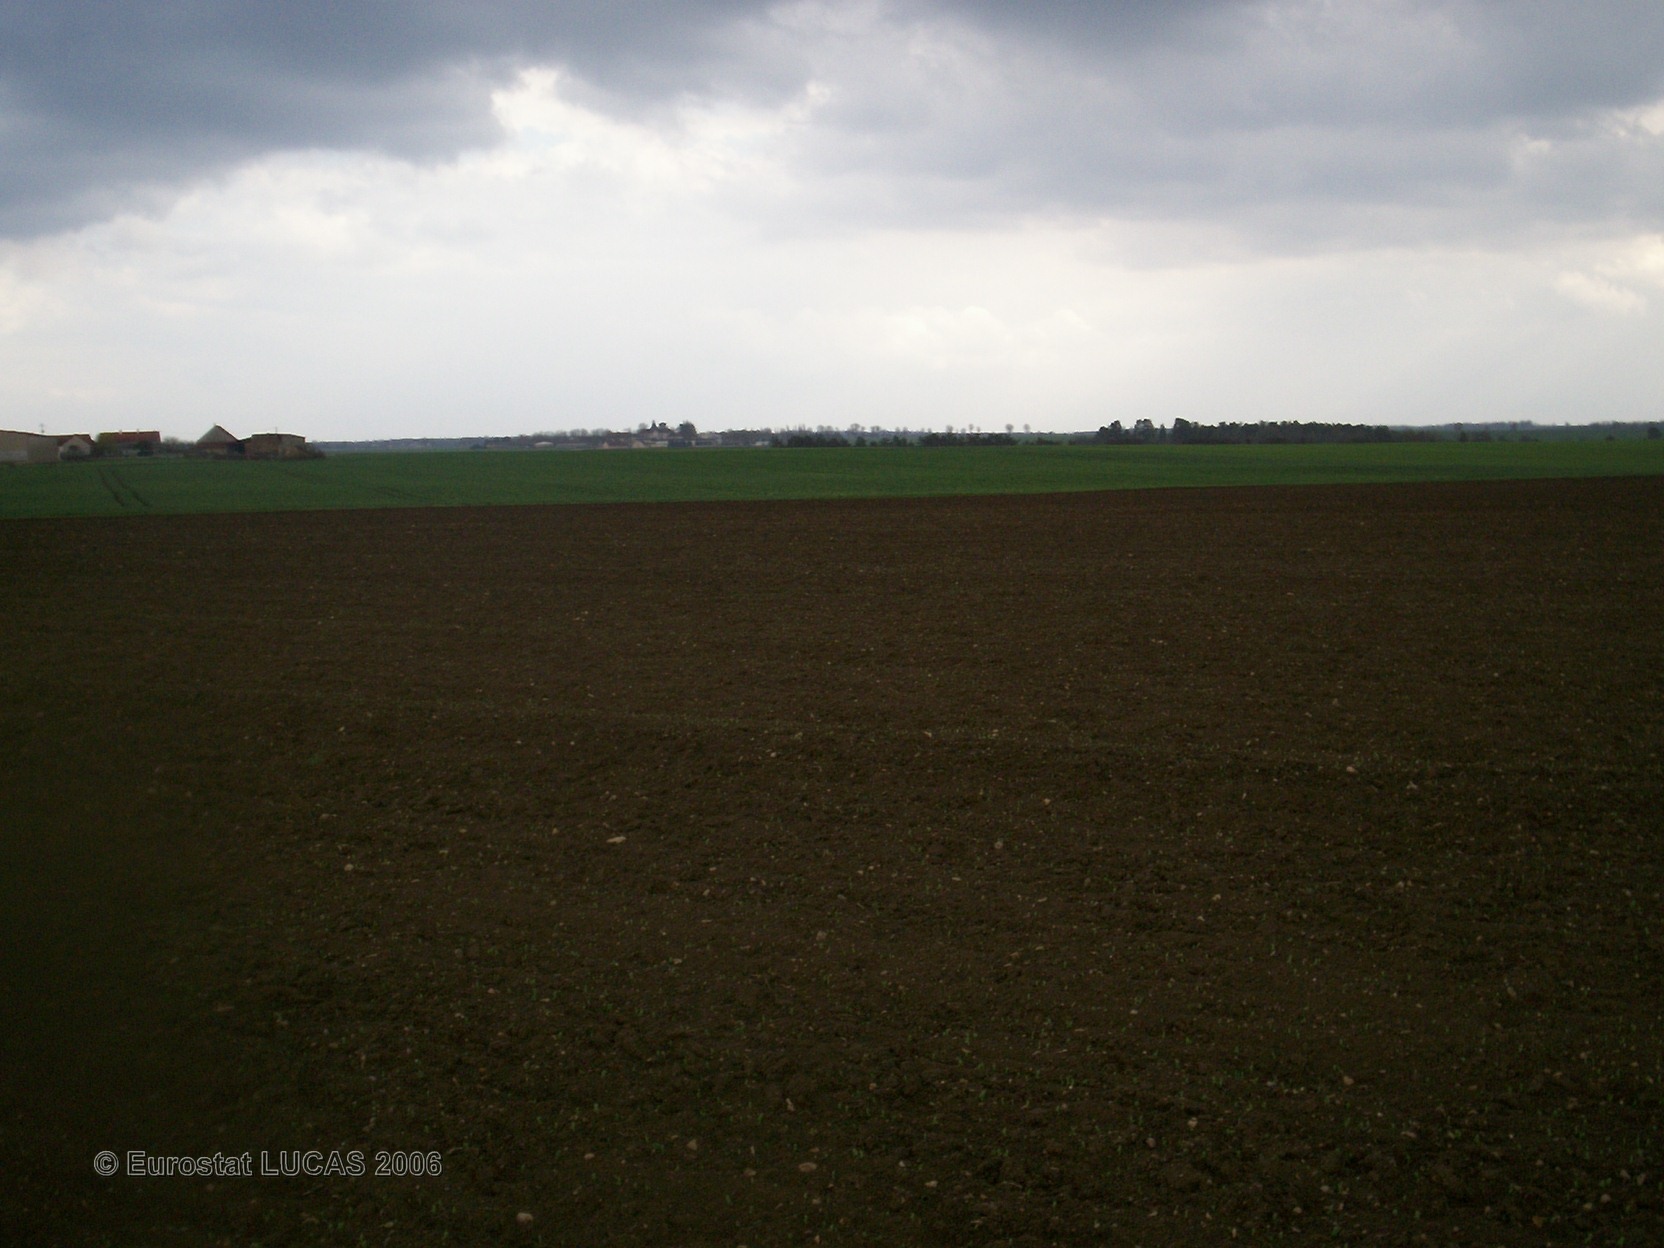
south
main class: Cropland
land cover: Dry pulses
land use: Agriculture (excluding fallow land and kitchen gardens)
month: April
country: FR
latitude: 47.8753
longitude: 4.6103
